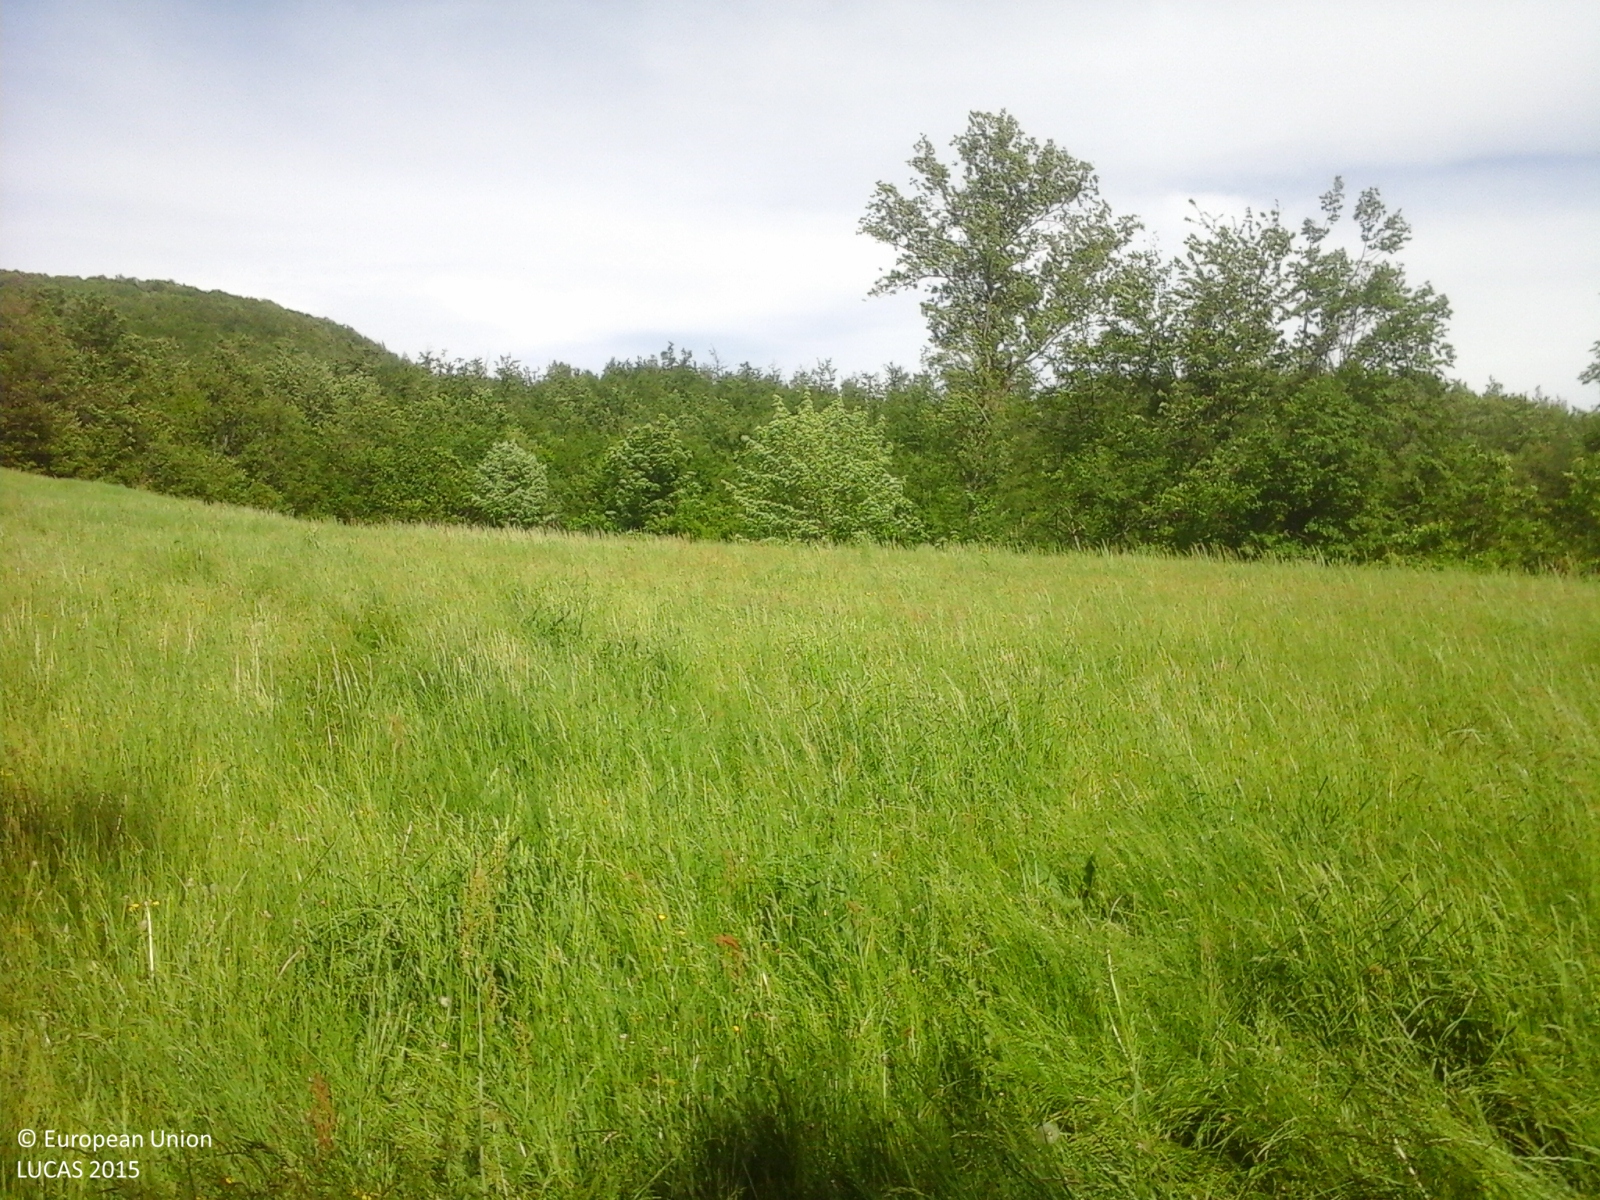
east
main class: Woodland
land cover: Broadleaved woodland
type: thermophilous deciduous forest
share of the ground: > 75 %
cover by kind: broadleaved forest trees 90 %, shrubs 10 %
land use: Forestry
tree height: > 5 m
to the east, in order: Broadleaved woodland; Lucerne; Broadleaved woodland; Rivers and streams; Broadleaved woodland
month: May
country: IT
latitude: 44.2025
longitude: 10.8863
